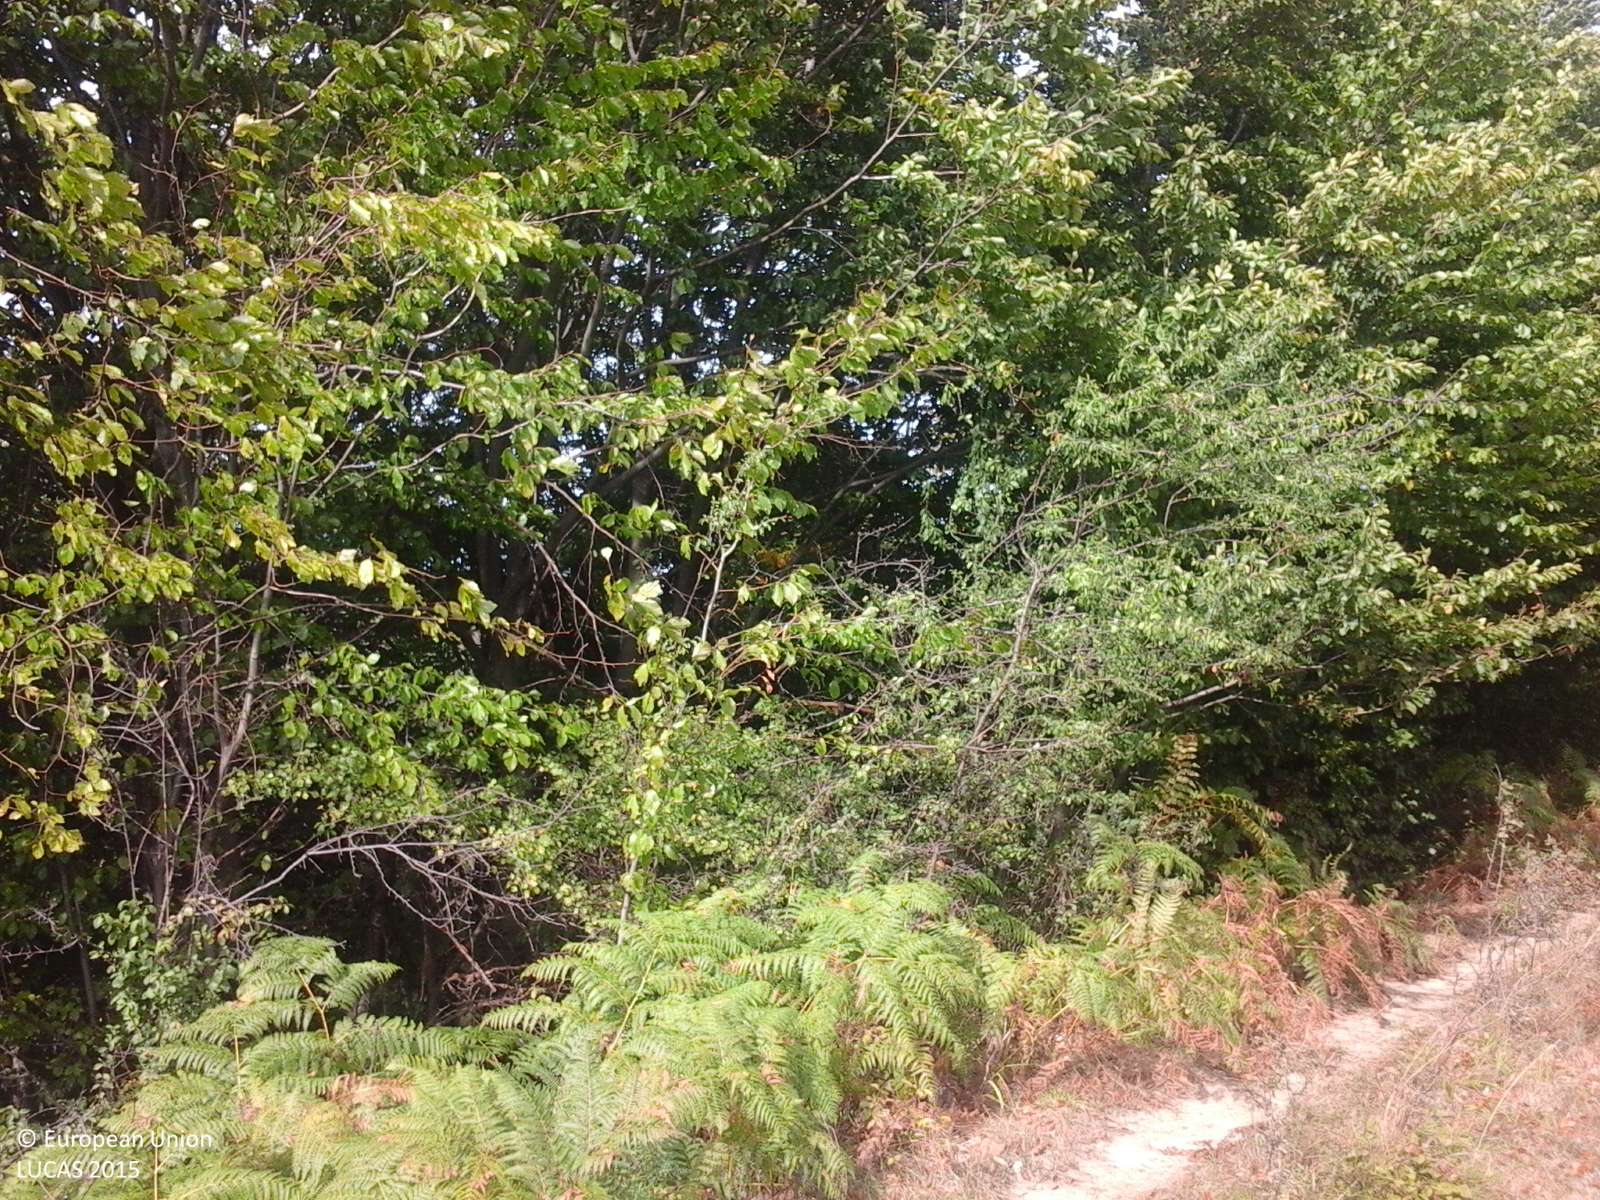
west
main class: Grassland
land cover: Grassland without tree/shrub cover
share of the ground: > 75 %
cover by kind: herbaceous plants 100 %
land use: Agriculture (excluding fallow land and kitchen gardens)
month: September
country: RO
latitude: 47.4353
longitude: 23.9914
